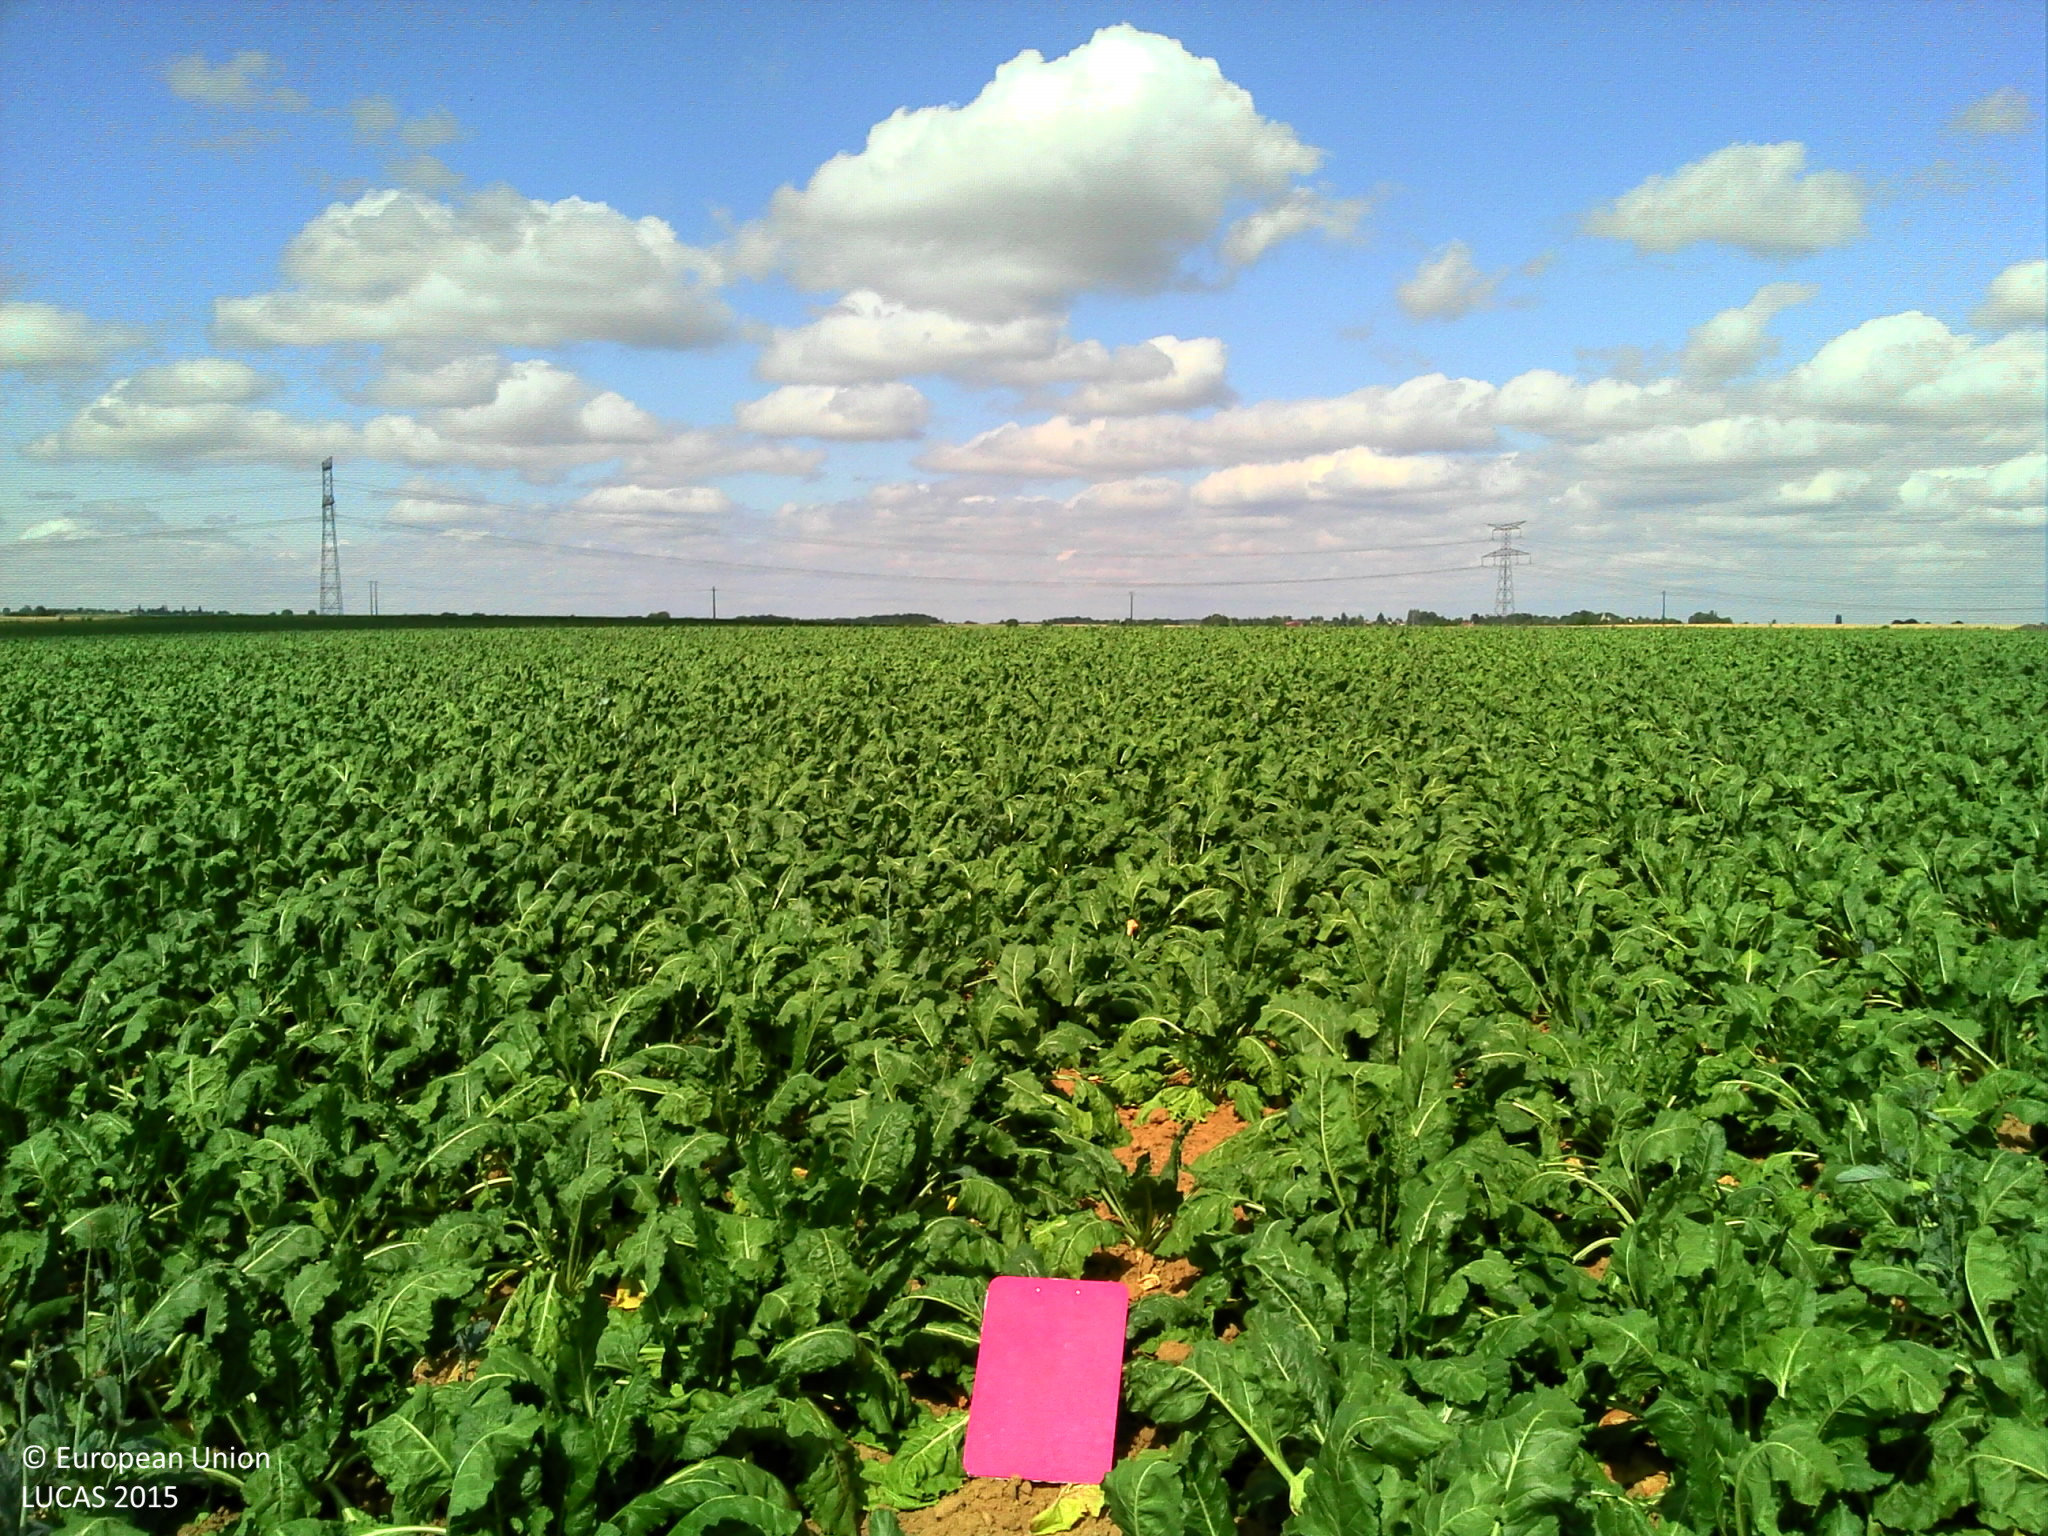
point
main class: Cropland
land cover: Sugar beet
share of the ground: > 75 %
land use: Agriculture (excluding fallow land and kitchen gardens)
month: July
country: FR
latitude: 49.2001
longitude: 2.2879
